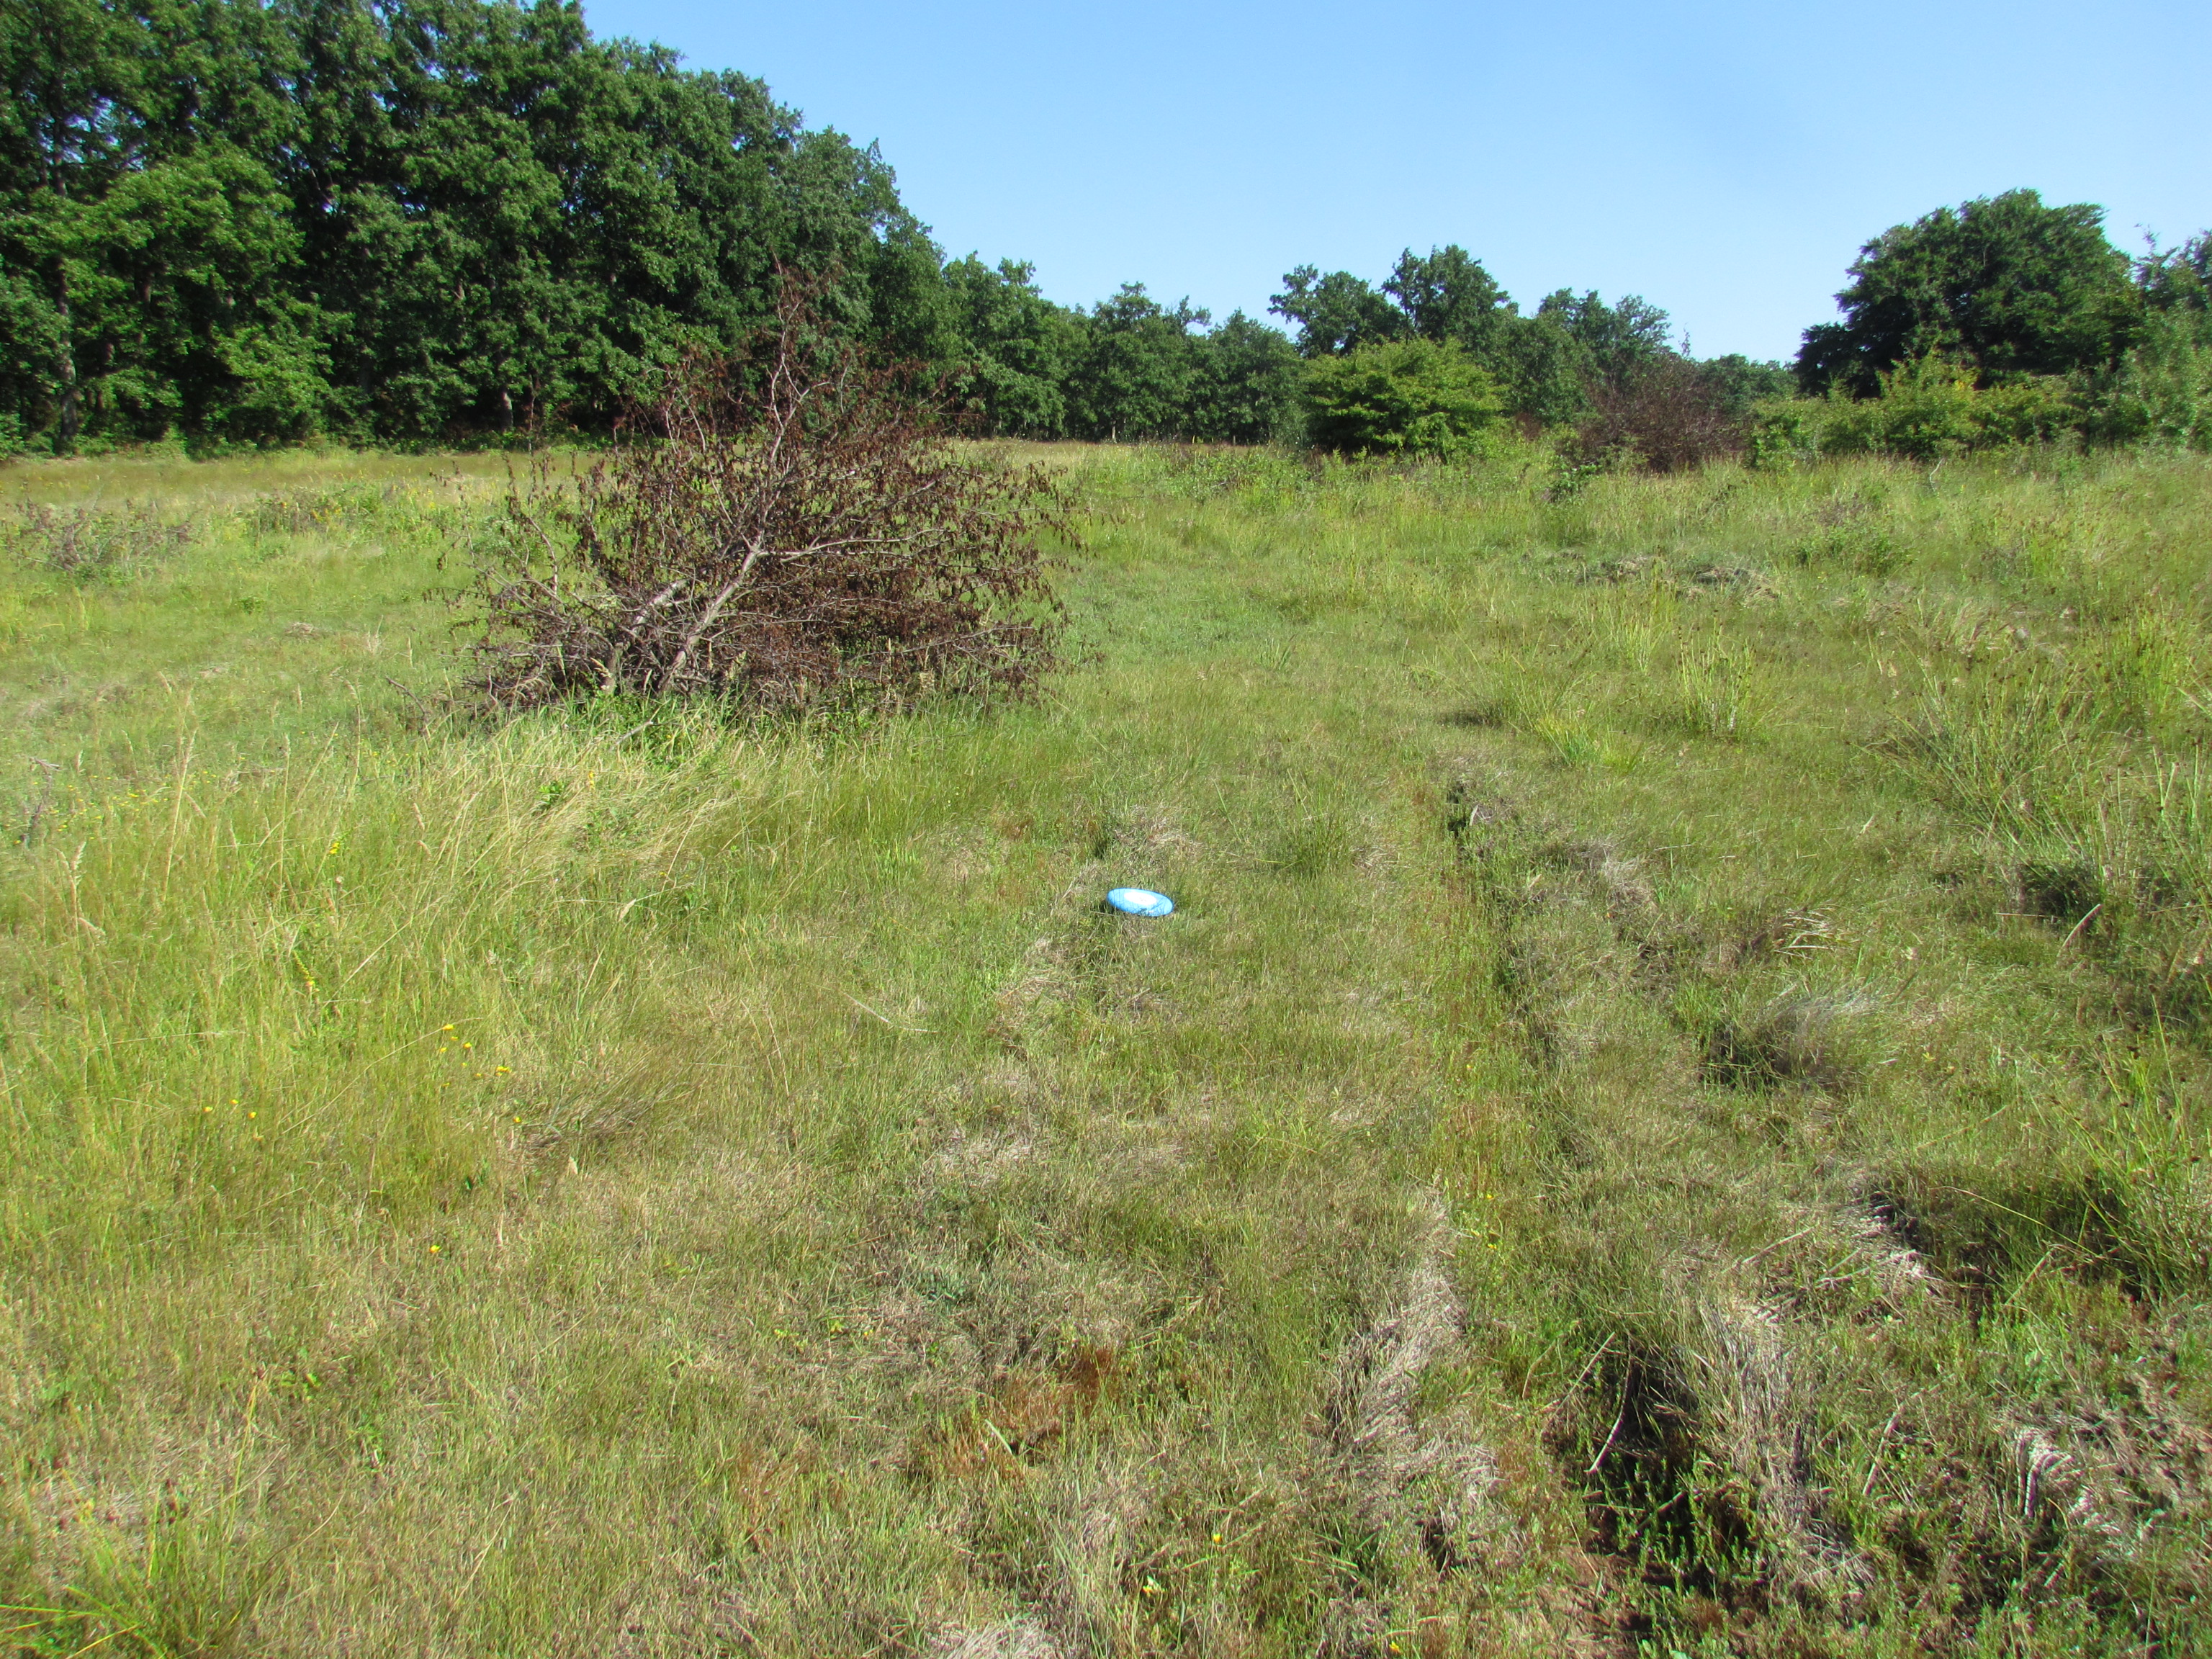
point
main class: Grassland
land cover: Grassland with sparse tree/shrub cover
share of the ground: > 75 %
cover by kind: herbaceous plants 90 %, broadleaved forest trees 5 %, shrubs 5 %
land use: Semi-natural and natural areas not in use
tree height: < 5 m
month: July
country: BG
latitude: 42.8256
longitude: 27.5295
